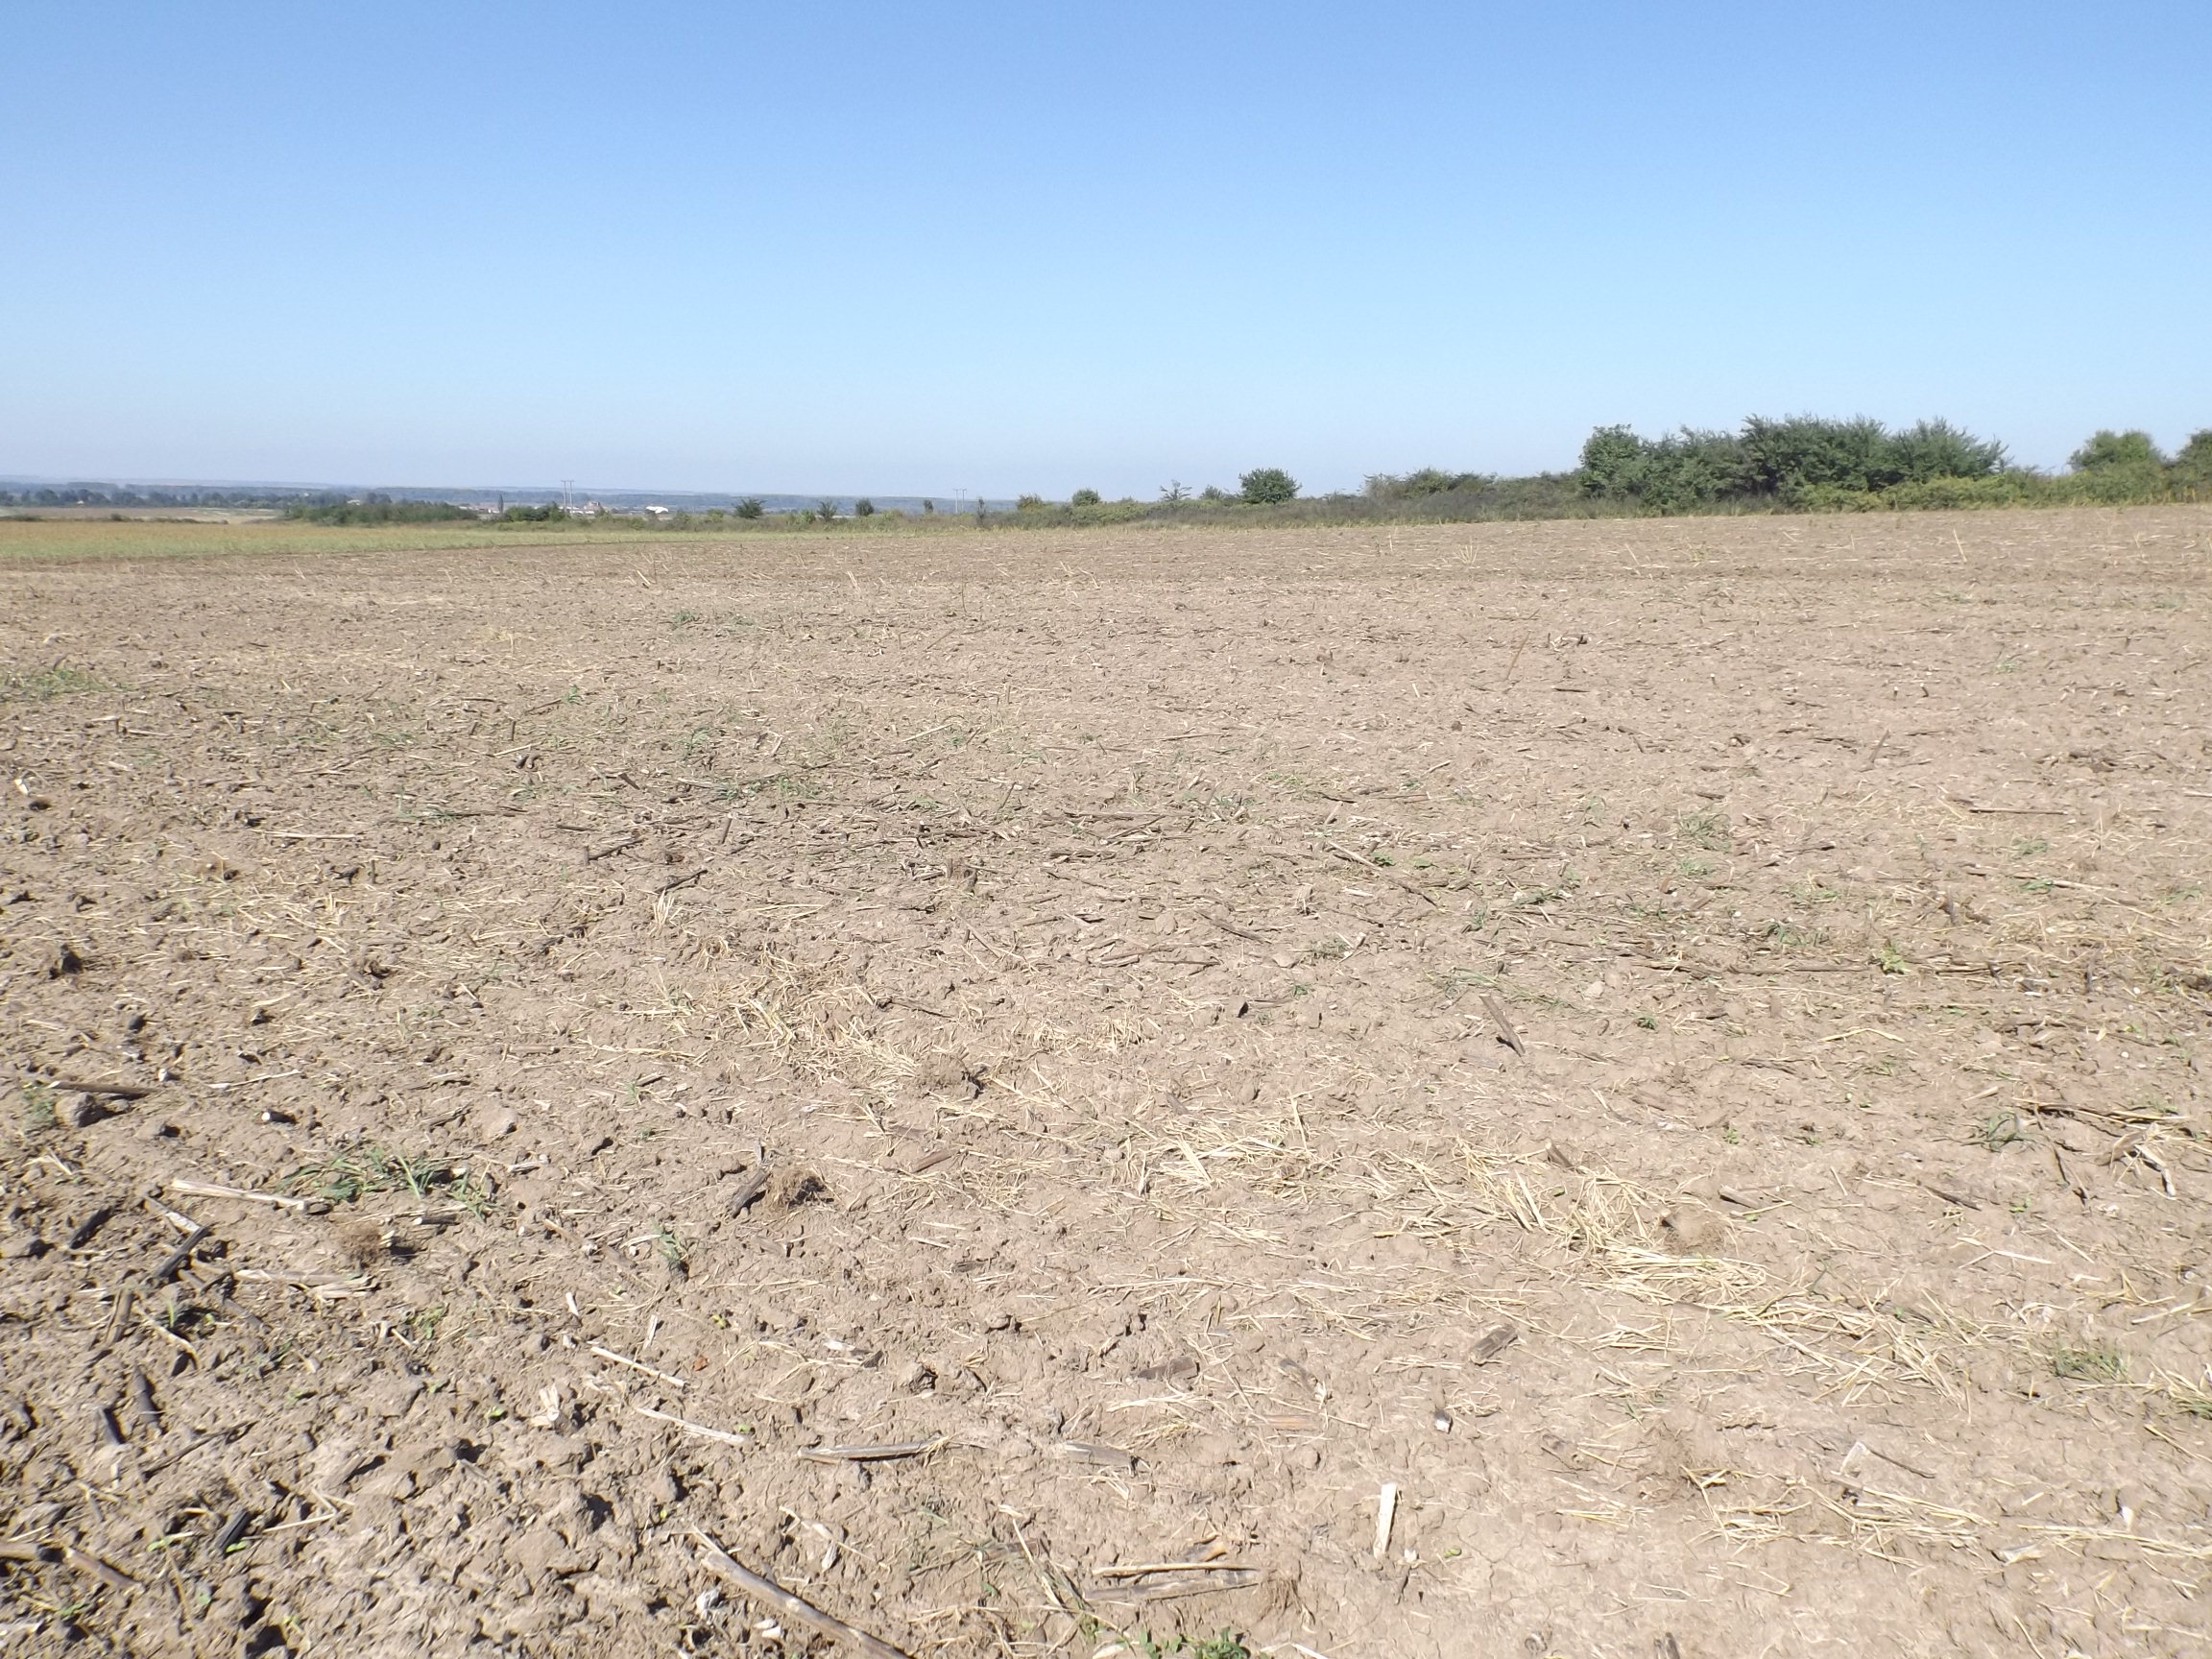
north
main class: Cropland
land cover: Sunflower
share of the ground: < 10 %
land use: Agriculture (excluding fallow land and kitchen gardens)
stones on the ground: < 10 %
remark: Harvested field
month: September
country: BG
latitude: 43.9916
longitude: 26.5073
